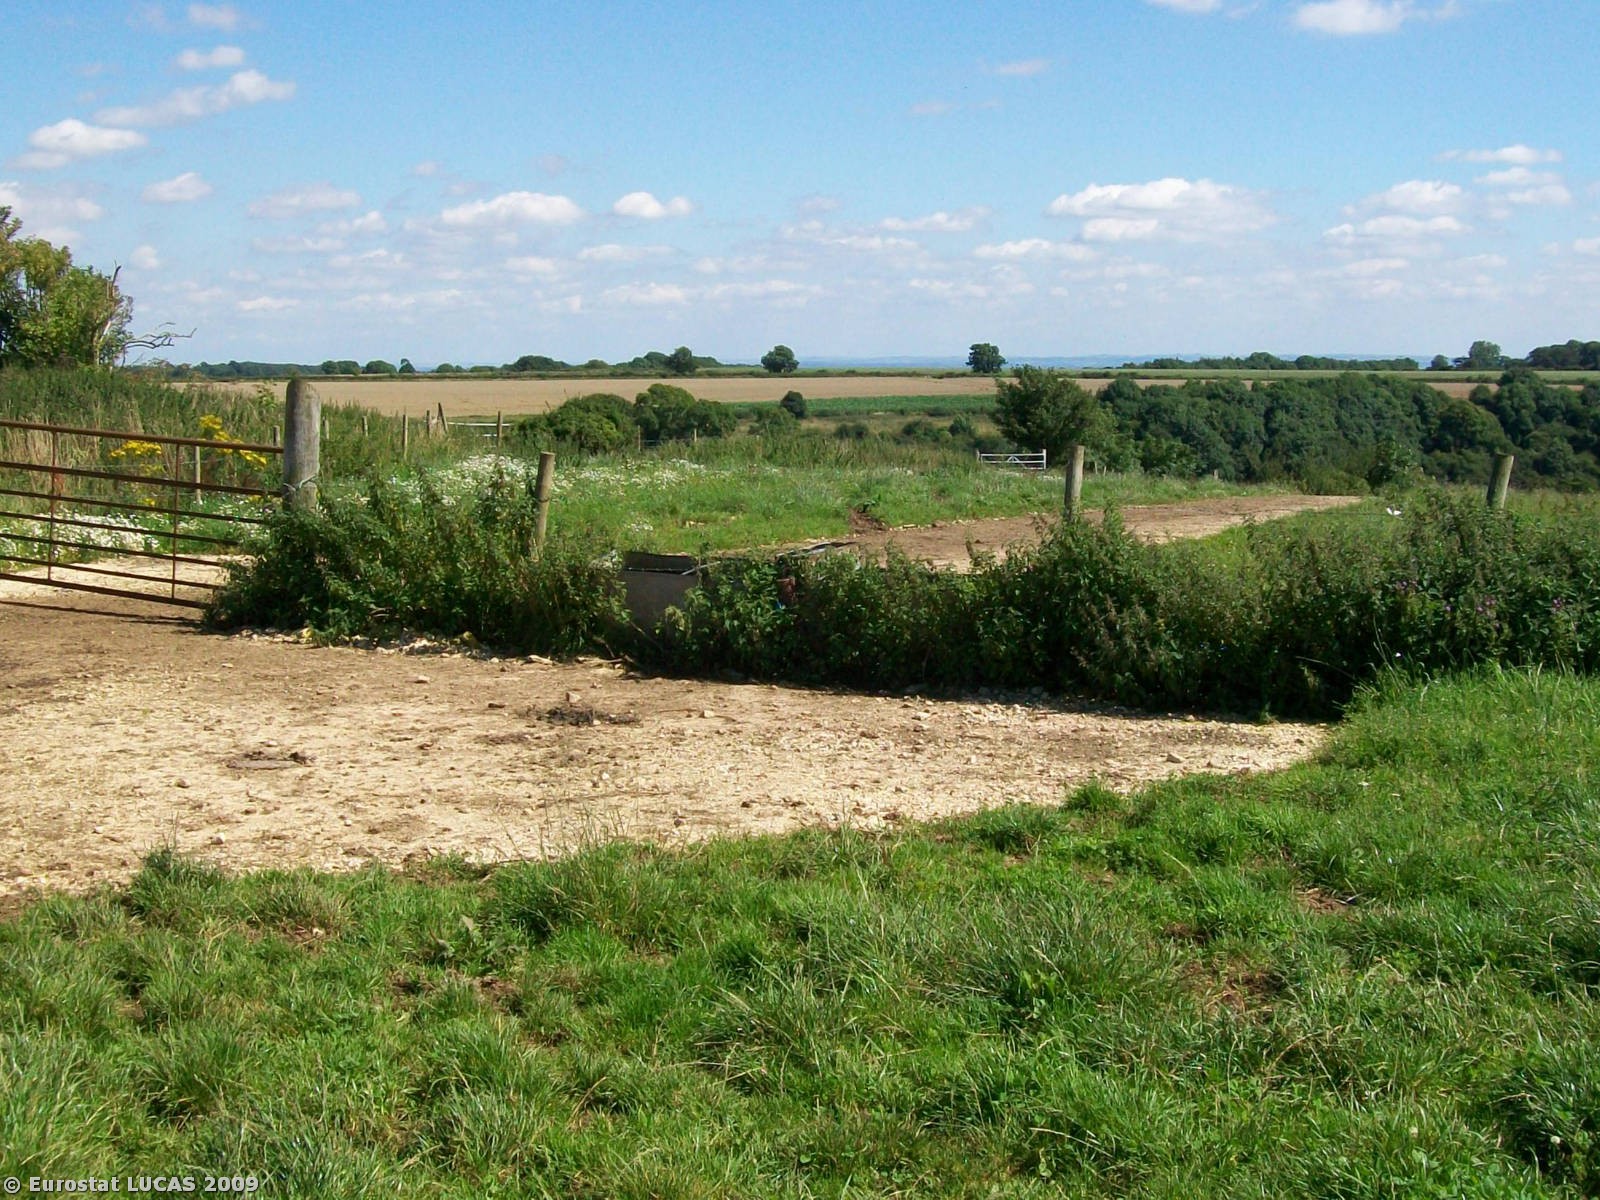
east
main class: Grassland
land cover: Grassland without tree/shrub cover
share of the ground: > 75 %
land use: Agriculture (excluding fallow land and kitchen gardens)
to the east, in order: Grassland without tree/shrub cover; Fences; Managed hedges; Grassland without tree/shrub cover
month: August
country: GB
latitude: 50.2031
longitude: -5.1810
